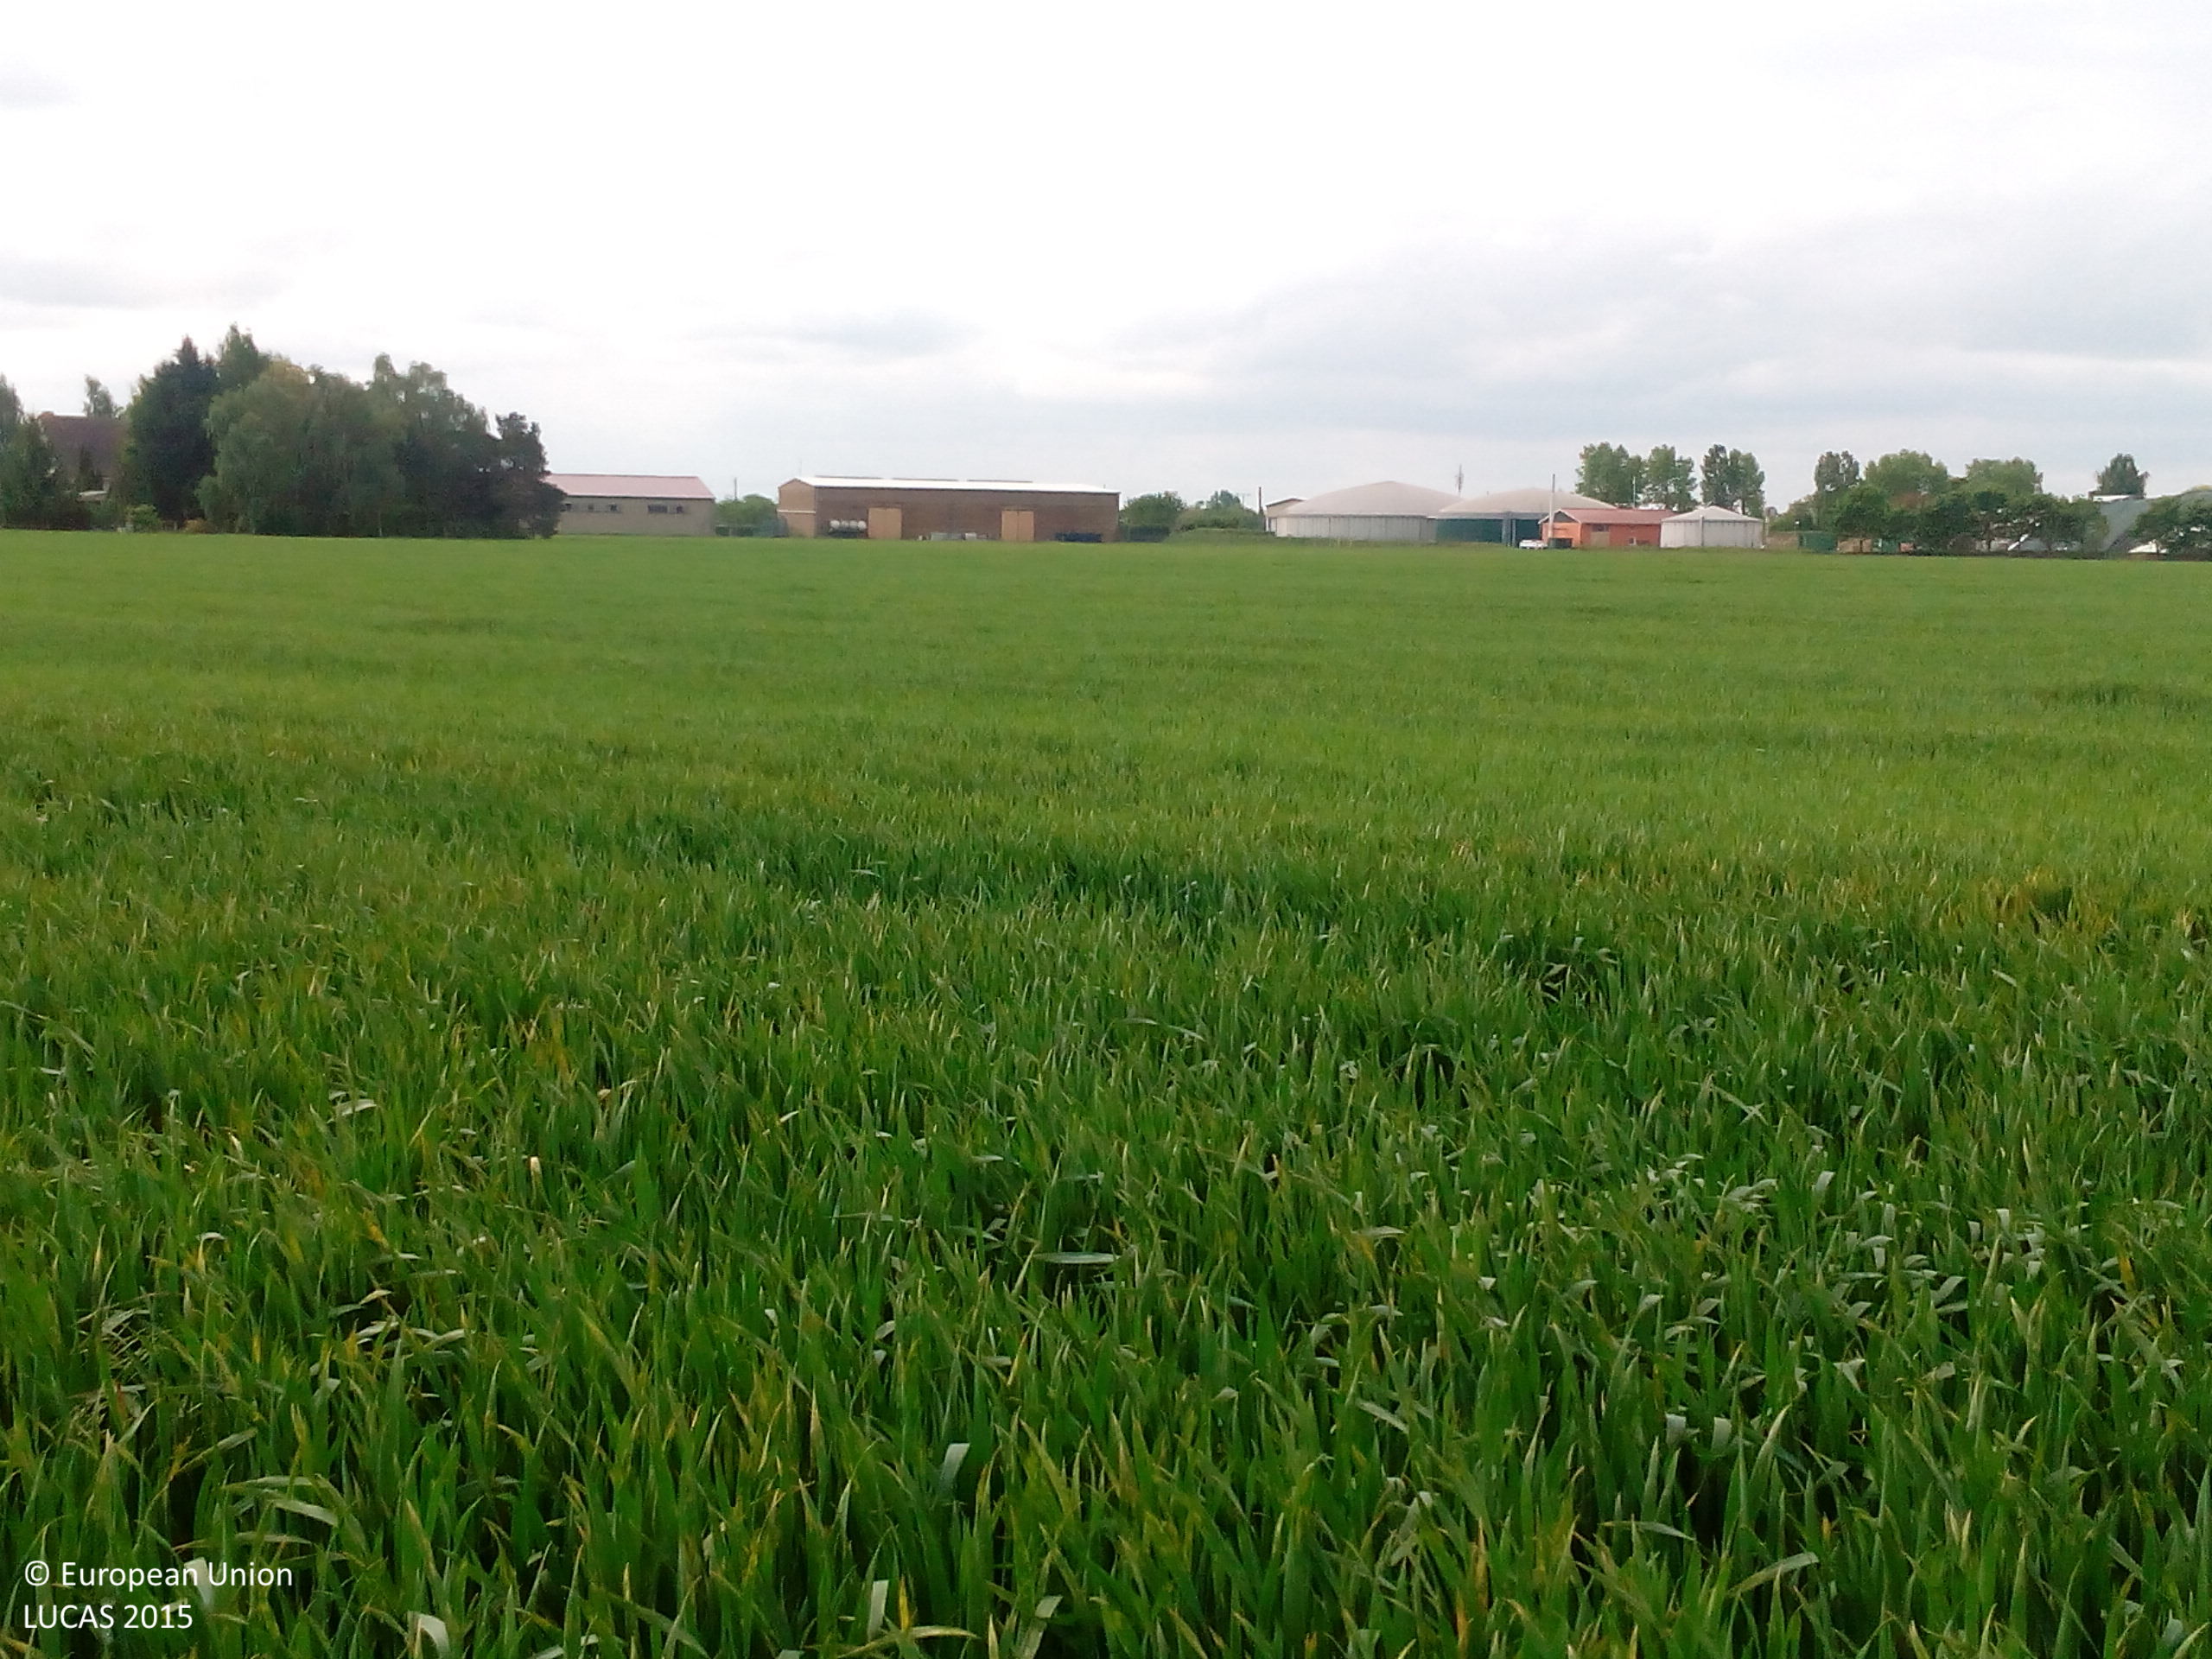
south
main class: Cropland
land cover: Common wheat
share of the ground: > 75 %
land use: Agriculture (excluding fallow land and kitchen gardens)
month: May
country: DE
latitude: 51.5658
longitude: 12.2069
